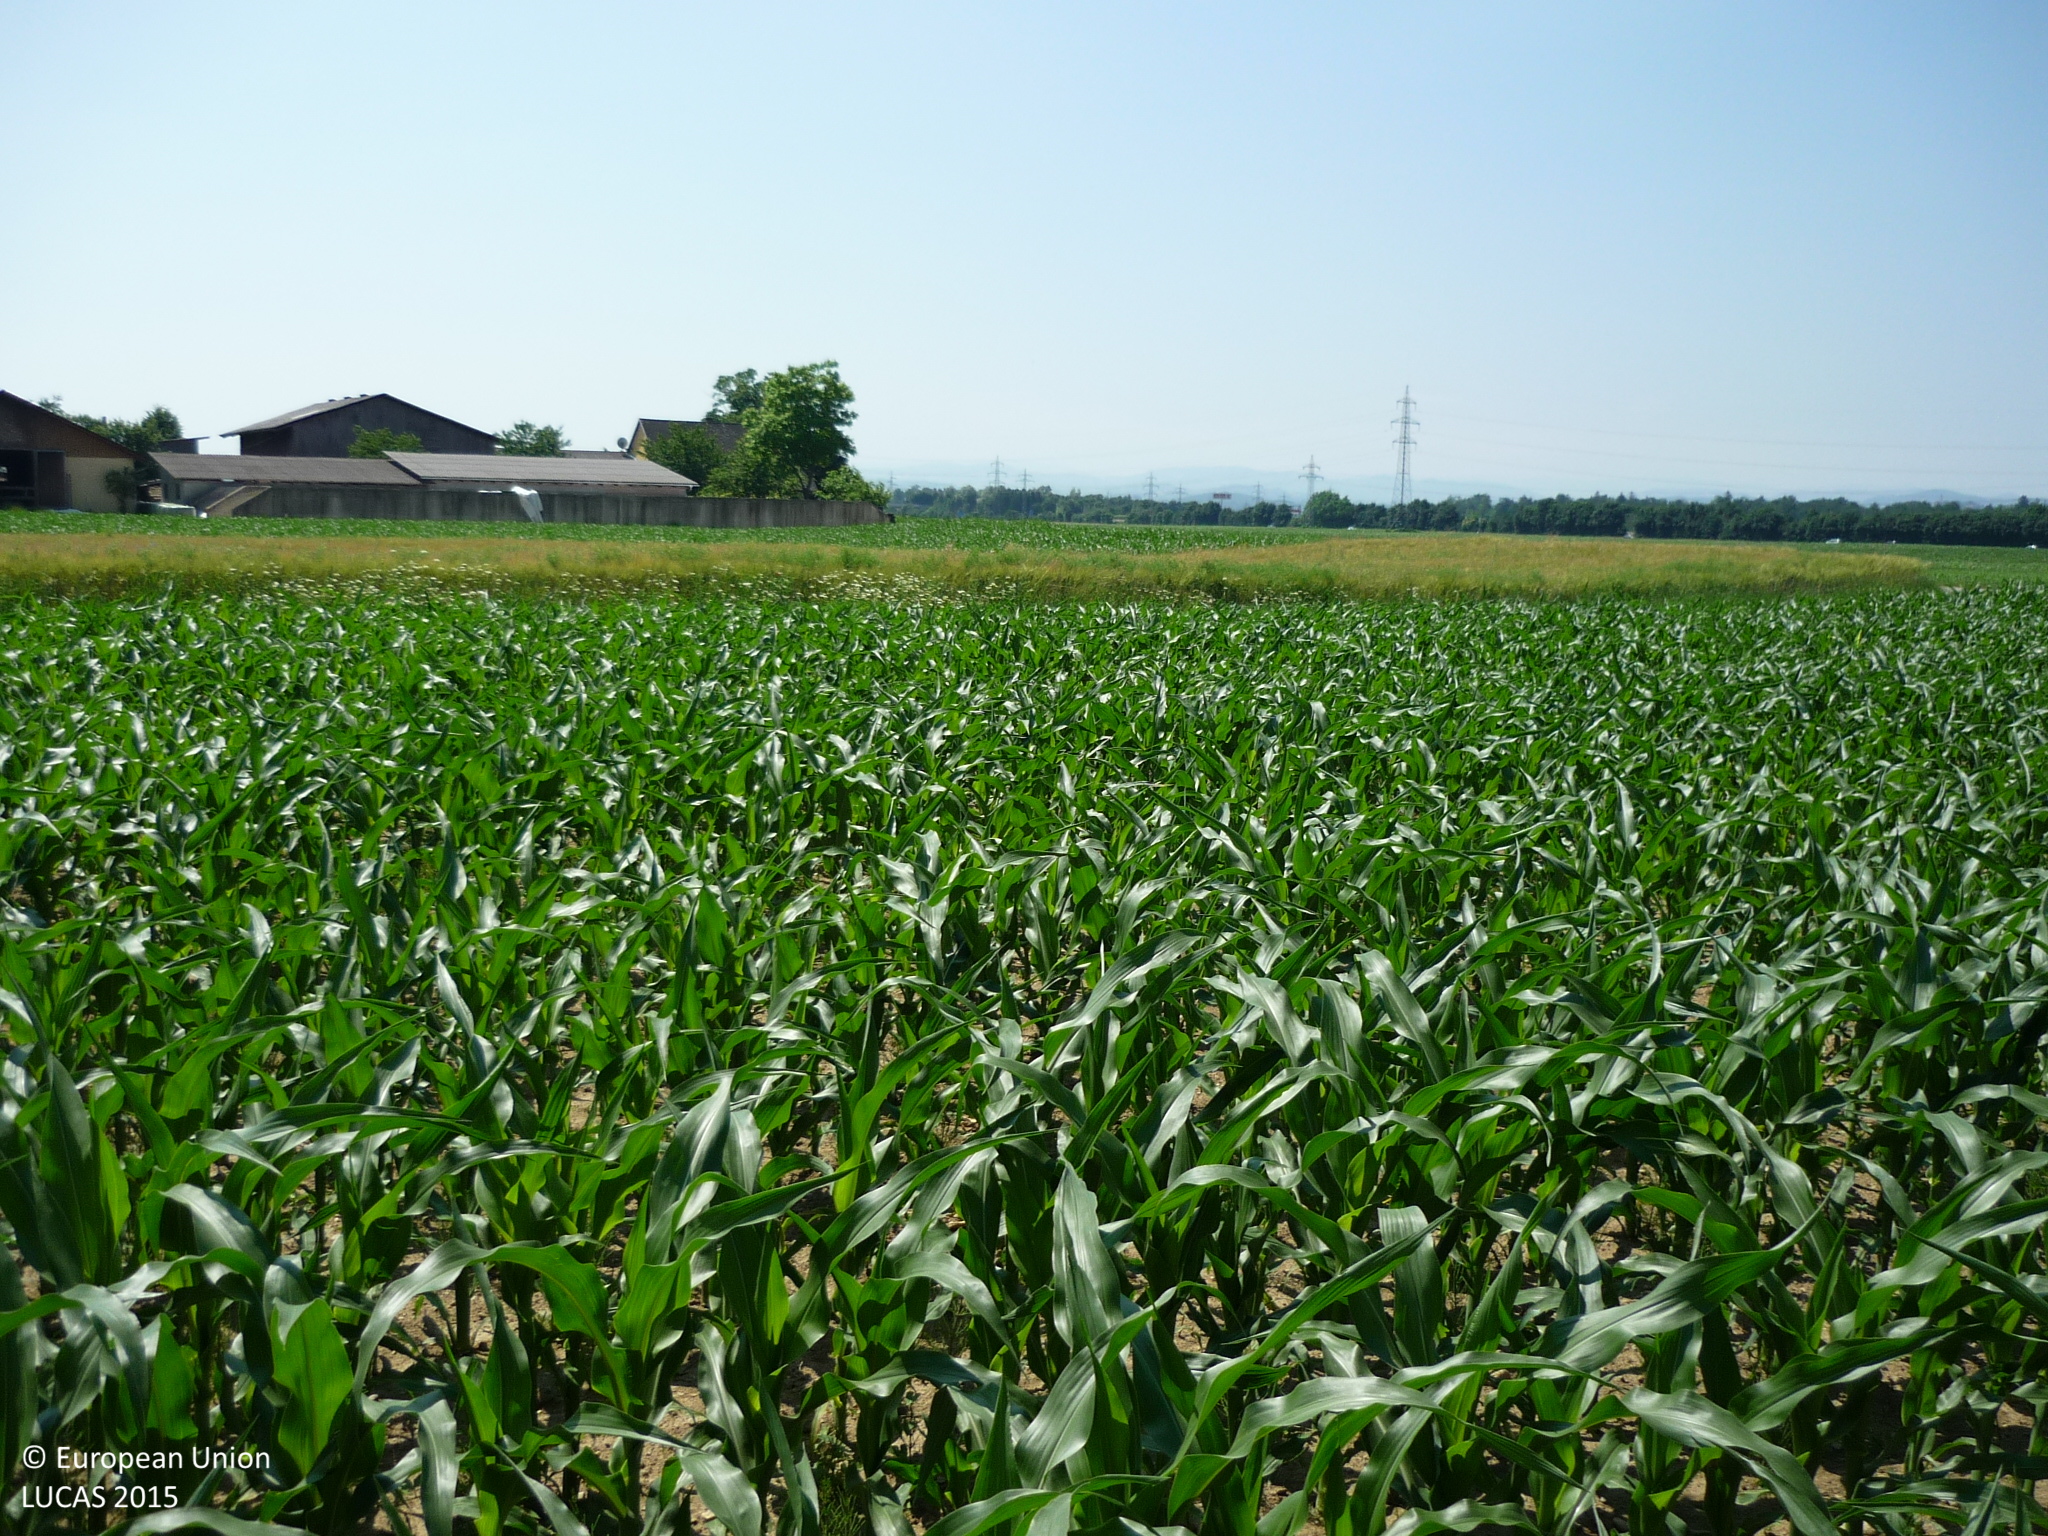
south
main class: Cropland
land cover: Maize
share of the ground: > 75 %
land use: Agriculture (excluding fallow land and kitchen gardens)
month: June
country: AT
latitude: 46.8198
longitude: 15.5701
